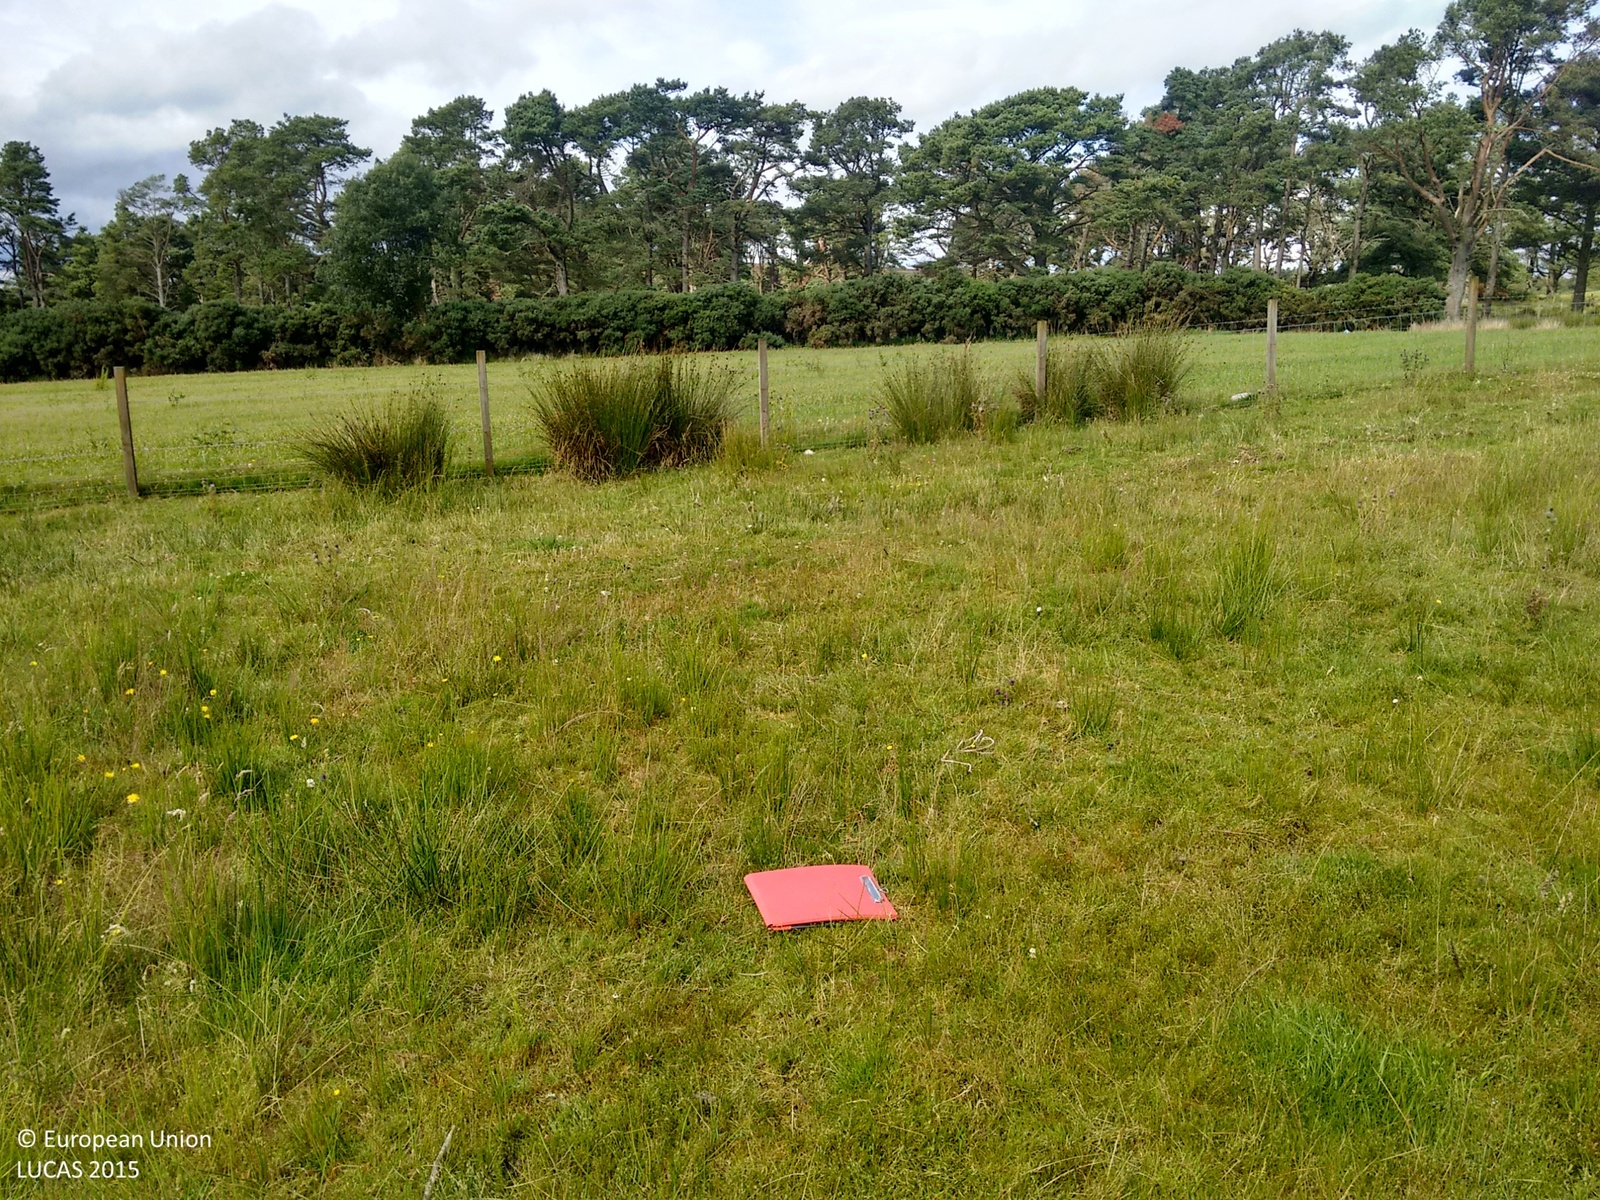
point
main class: Grassland
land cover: Grassland without tree/shrub cover
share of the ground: > 75 %
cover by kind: herbaceous plants 100 %
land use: Agriculture (excluding fallow land and kitchen gardens)
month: August
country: GB
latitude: 57.9097
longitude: -4.1048
